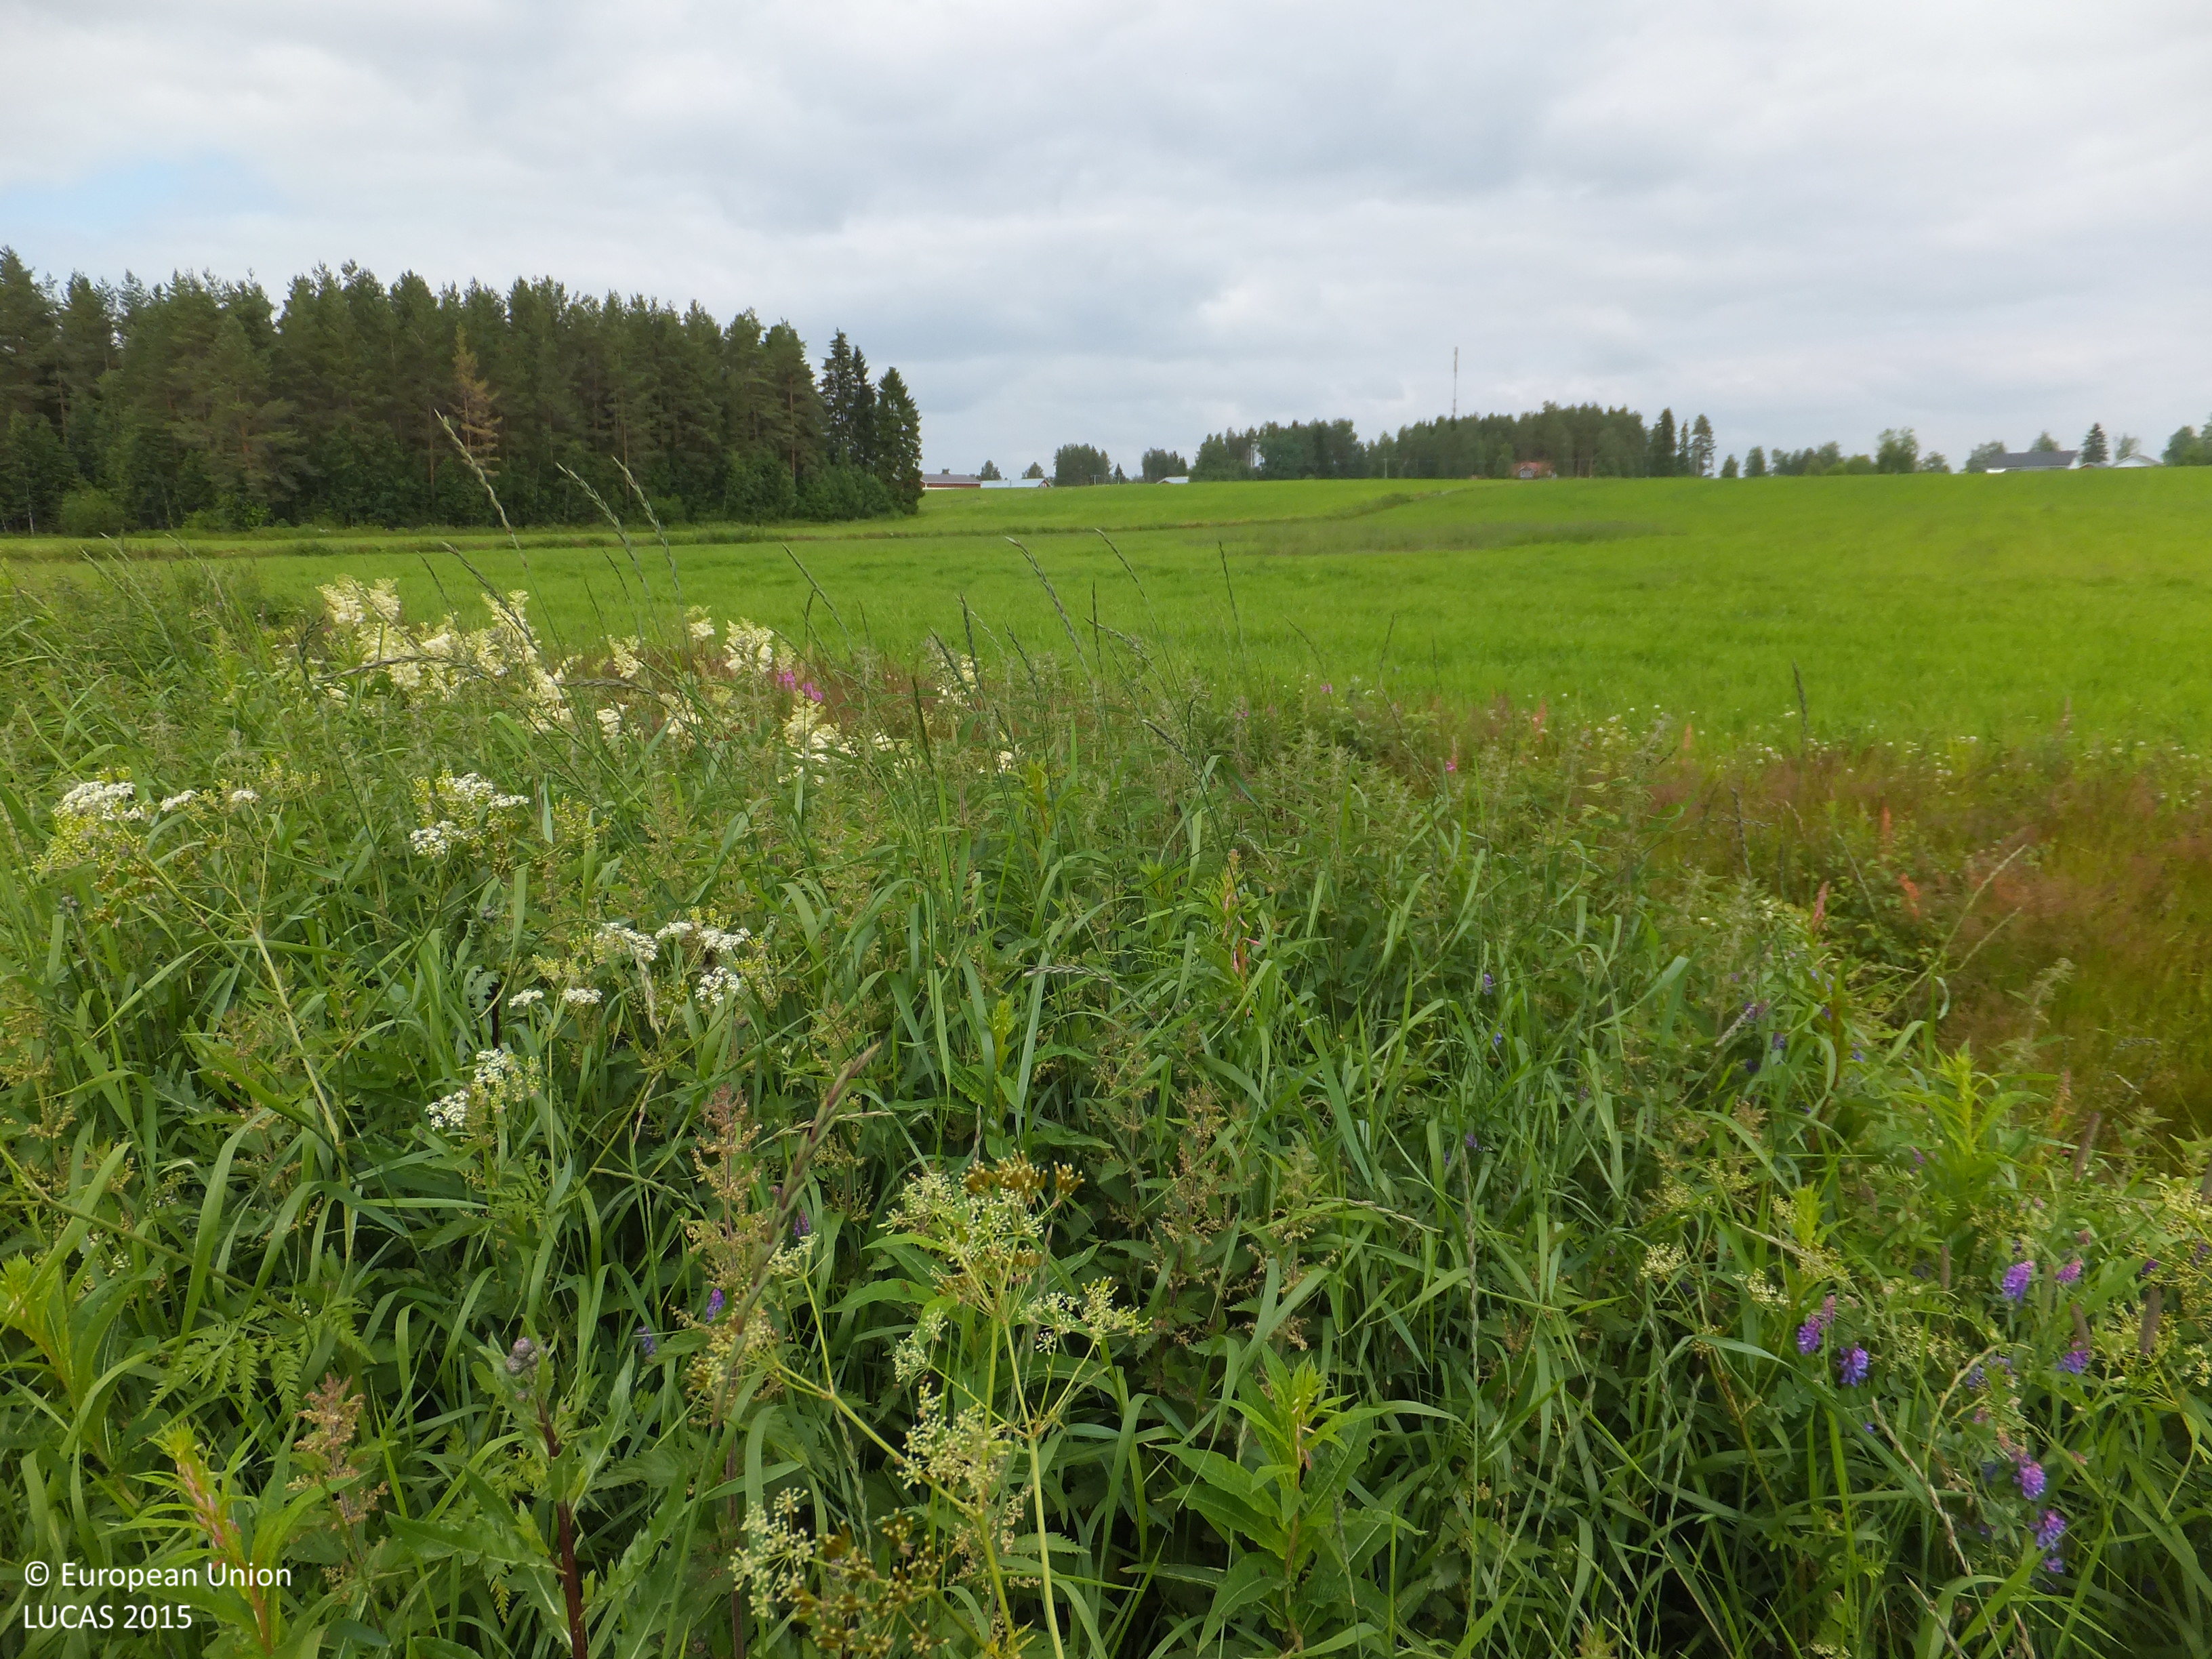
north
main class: Grassland
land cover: Grassland without tree/shrub cover
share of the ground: > 75 %
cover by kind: herbaceous plants 100 %
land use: Agriculture (excluding fallow land and kitchen gardens)
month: July
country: FI
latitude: 63.4755
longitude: 23.0000
